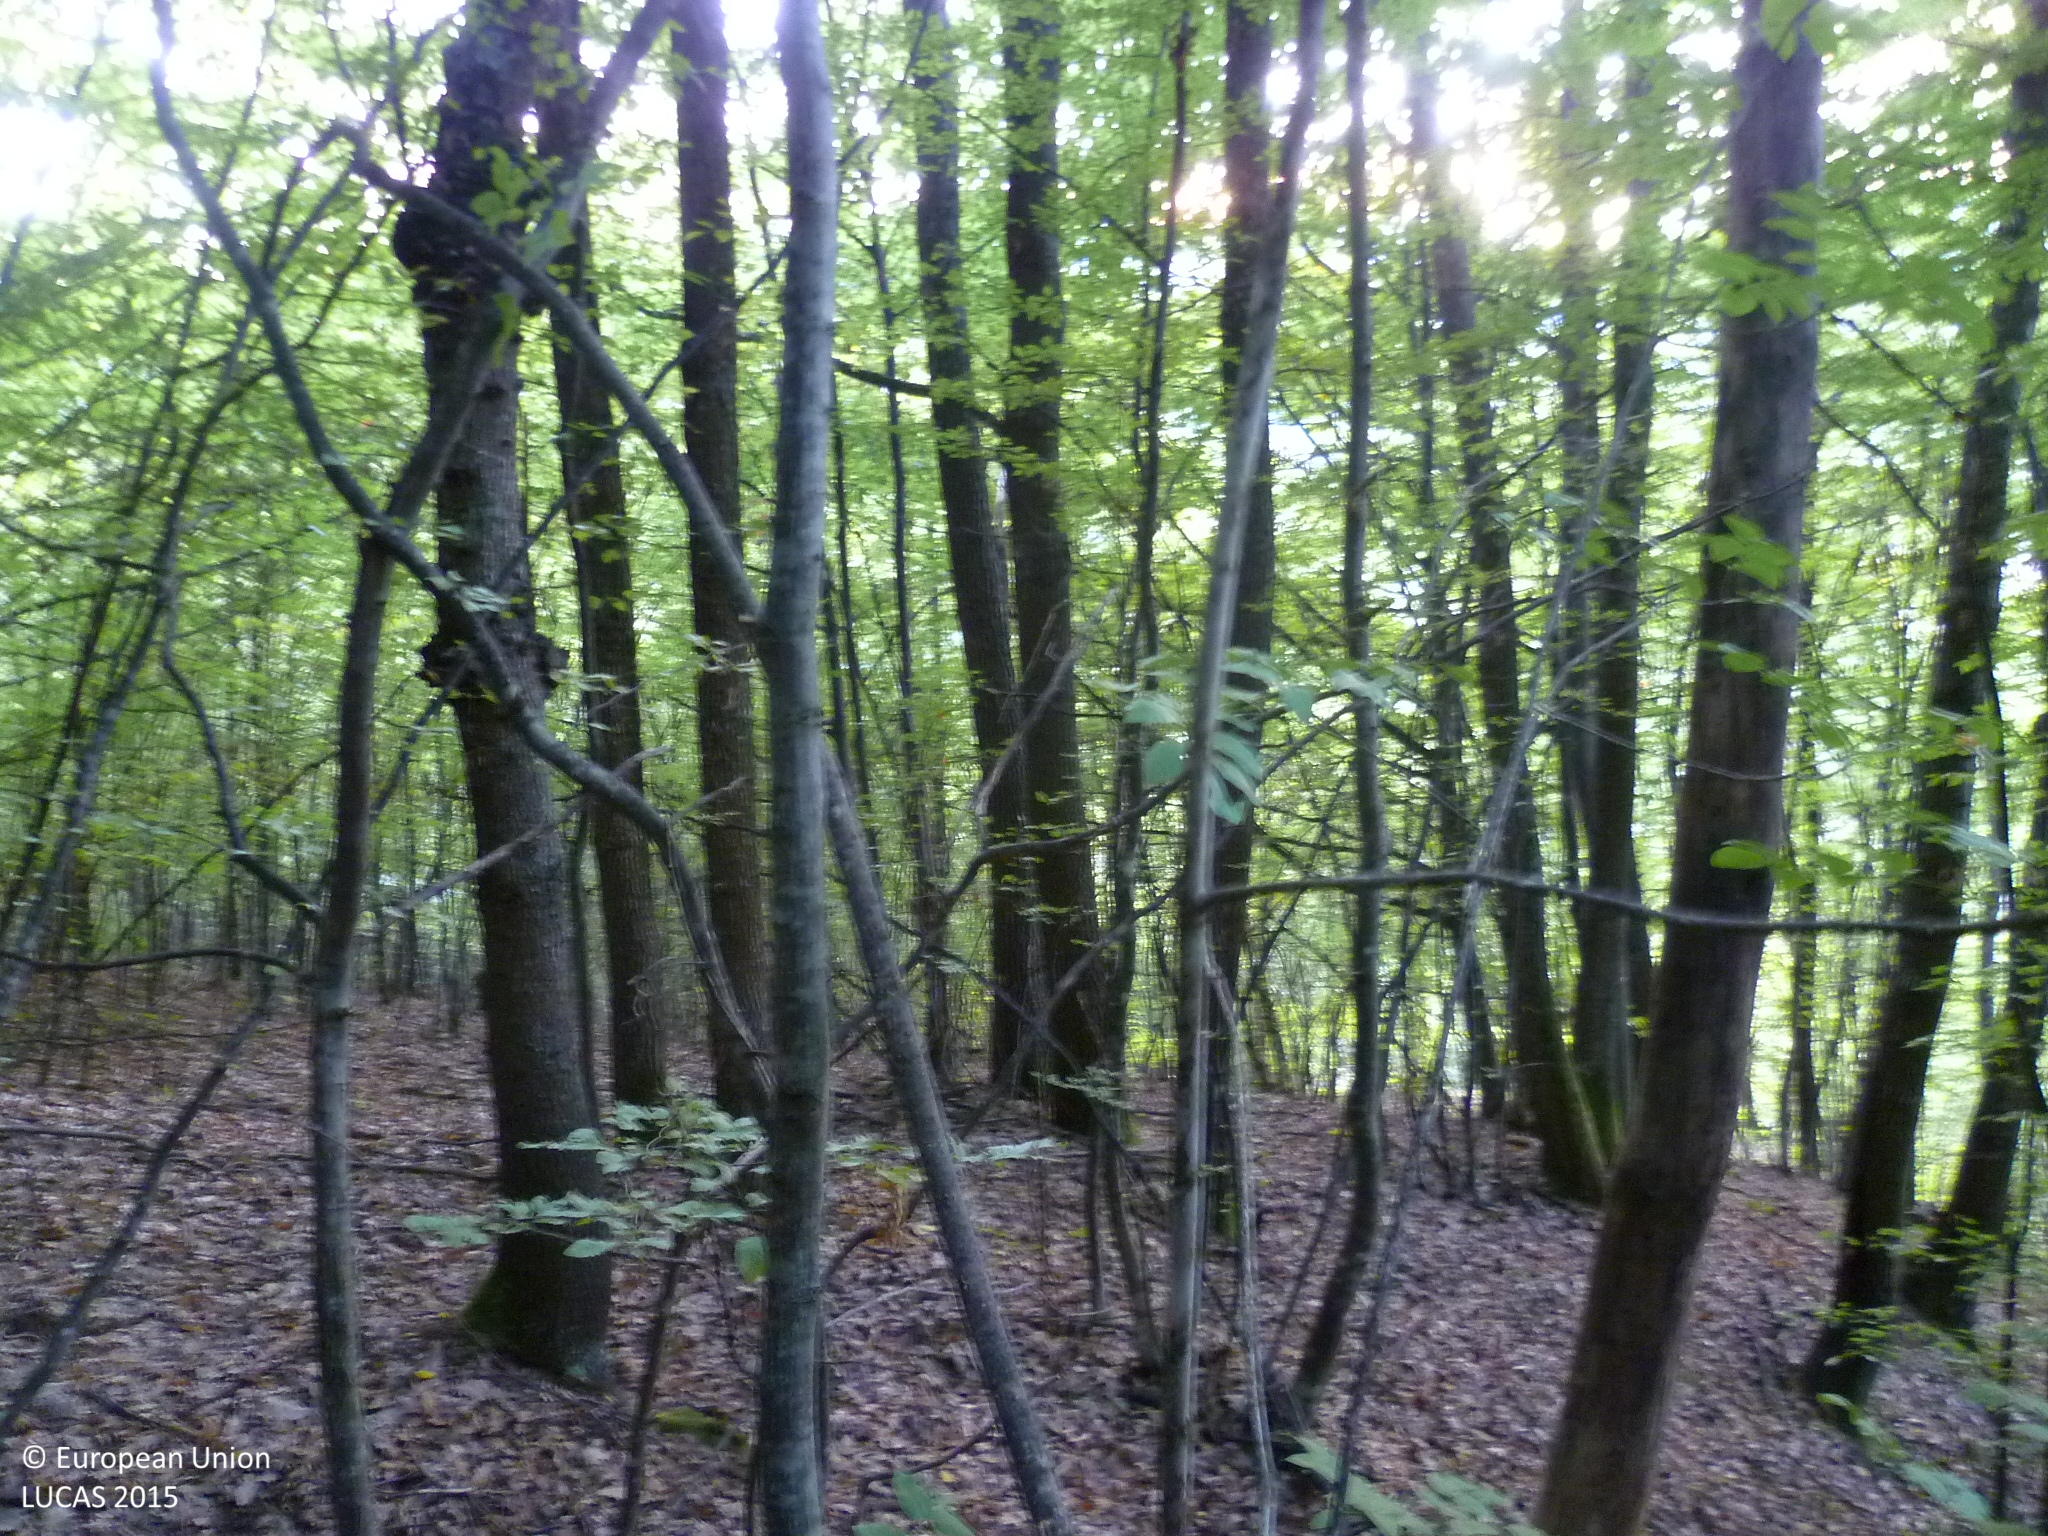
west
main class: Woodland
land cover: Broadleaved woodland
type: mesophytic deciduous forest
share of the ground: > 75 %
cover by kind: broadleaved forest trees 80 %, unconsolidated bare surface 20 %
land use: Forestry
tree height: > 5 m
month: October
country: BG
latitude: 42.8823
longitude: 22.7738
